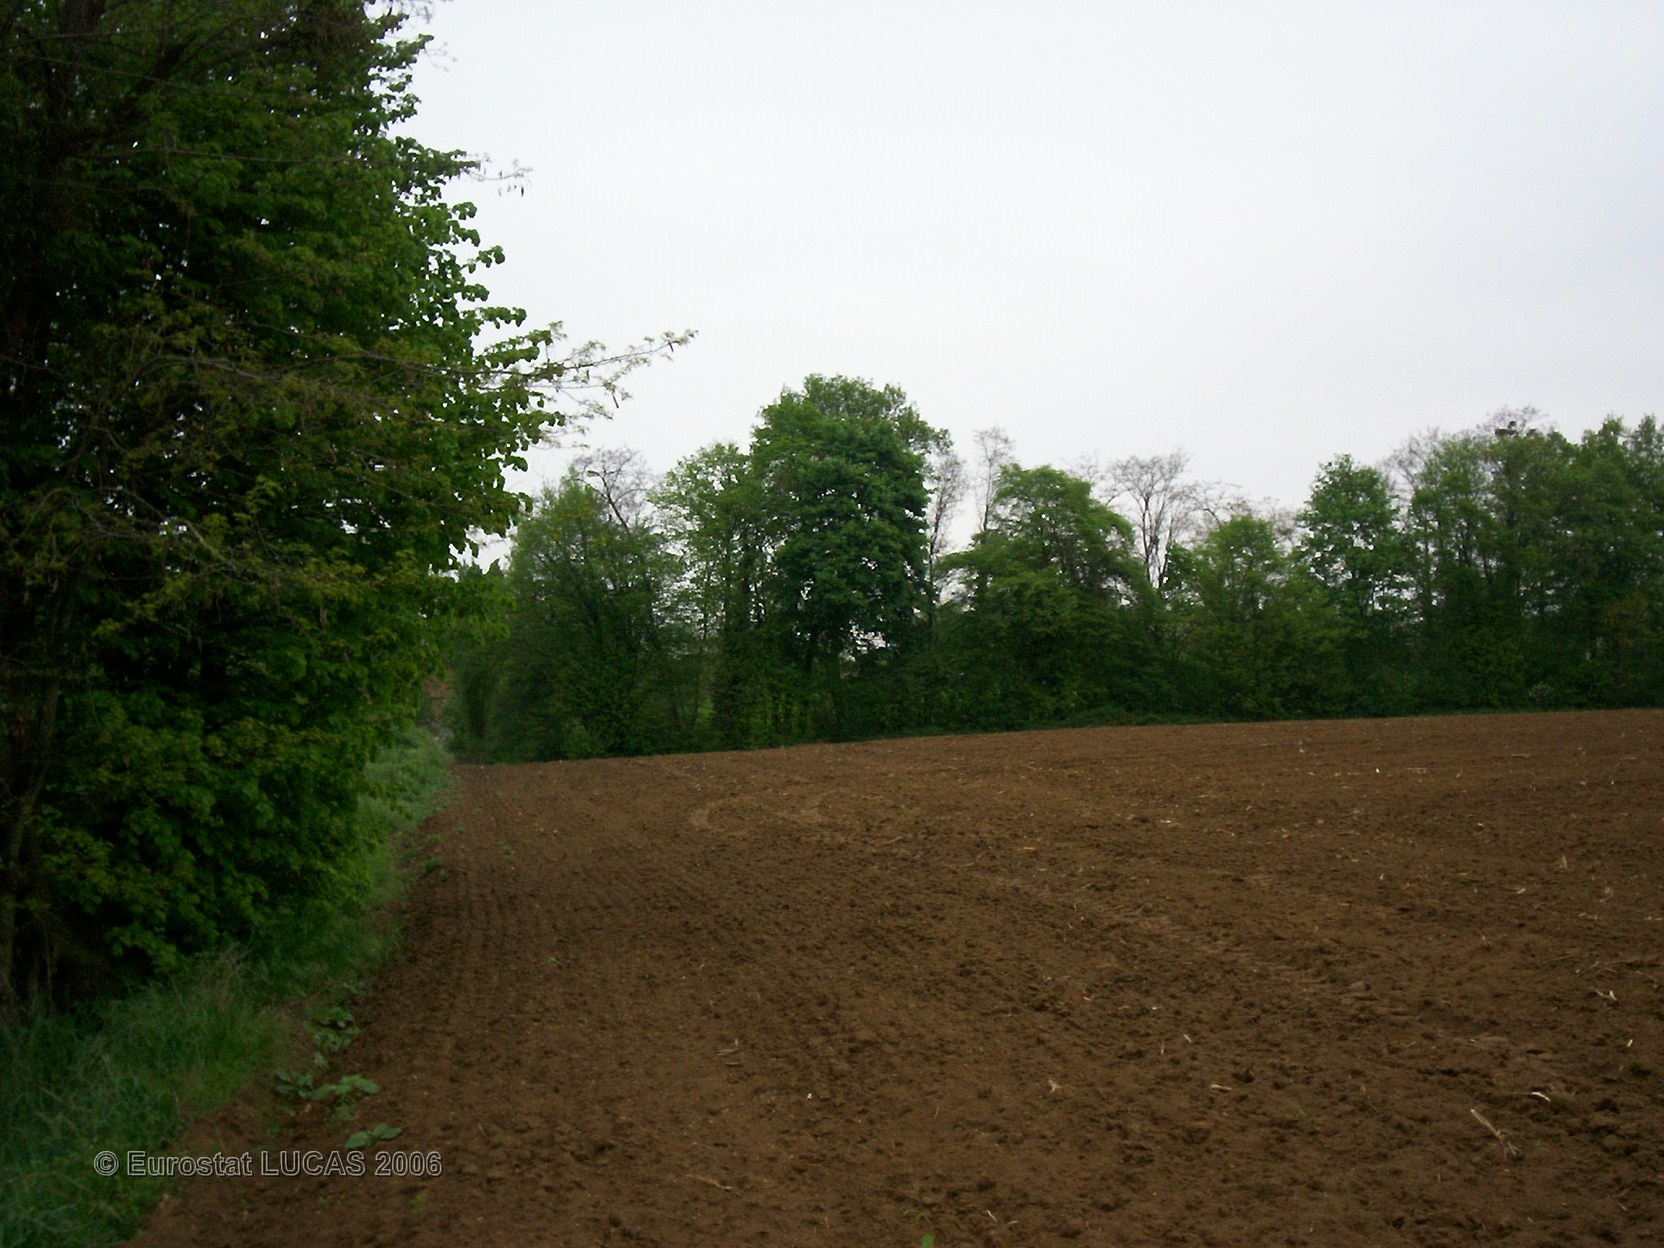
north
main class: Cropland
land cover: Maize
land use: Agriculture (excluding fallow land and kitchen gardens)
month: June
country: FR
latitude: 46.0428
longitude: 4.7692
